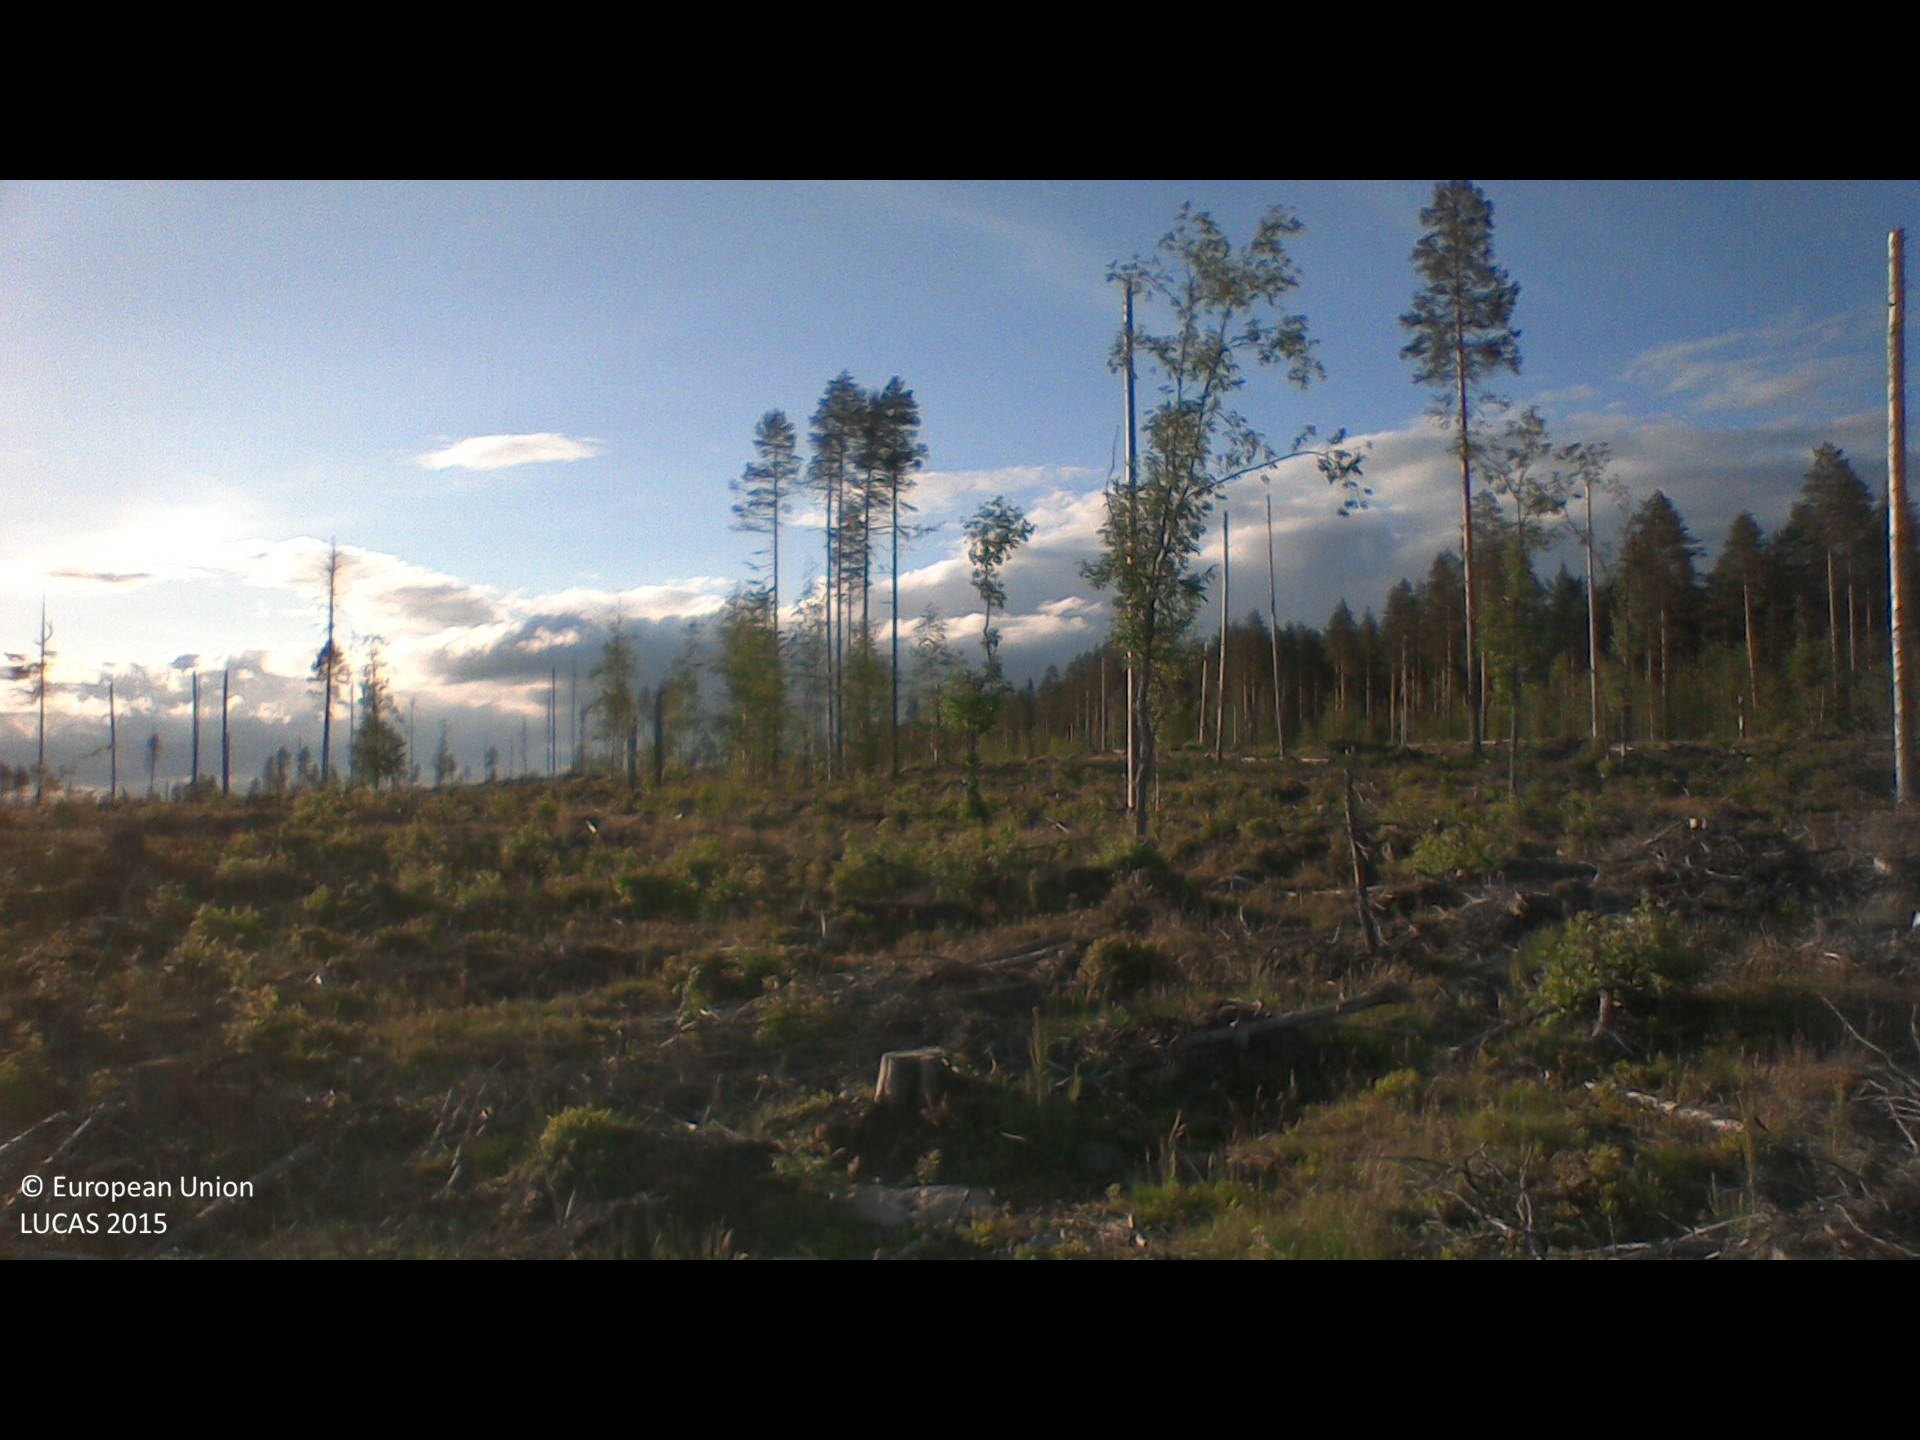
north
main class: Shrubland
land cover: Shrubland with sparse tree cover
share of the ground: 10 - 25 %
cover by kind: unconsolidated bare surface 45 %, shrubs 25 %, herbaceous plants 25 %, broadleaved forest trees 5 %
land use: Forestry
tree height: < 5 m
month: July
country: SE
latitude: 66.8864
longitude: 23.0994
